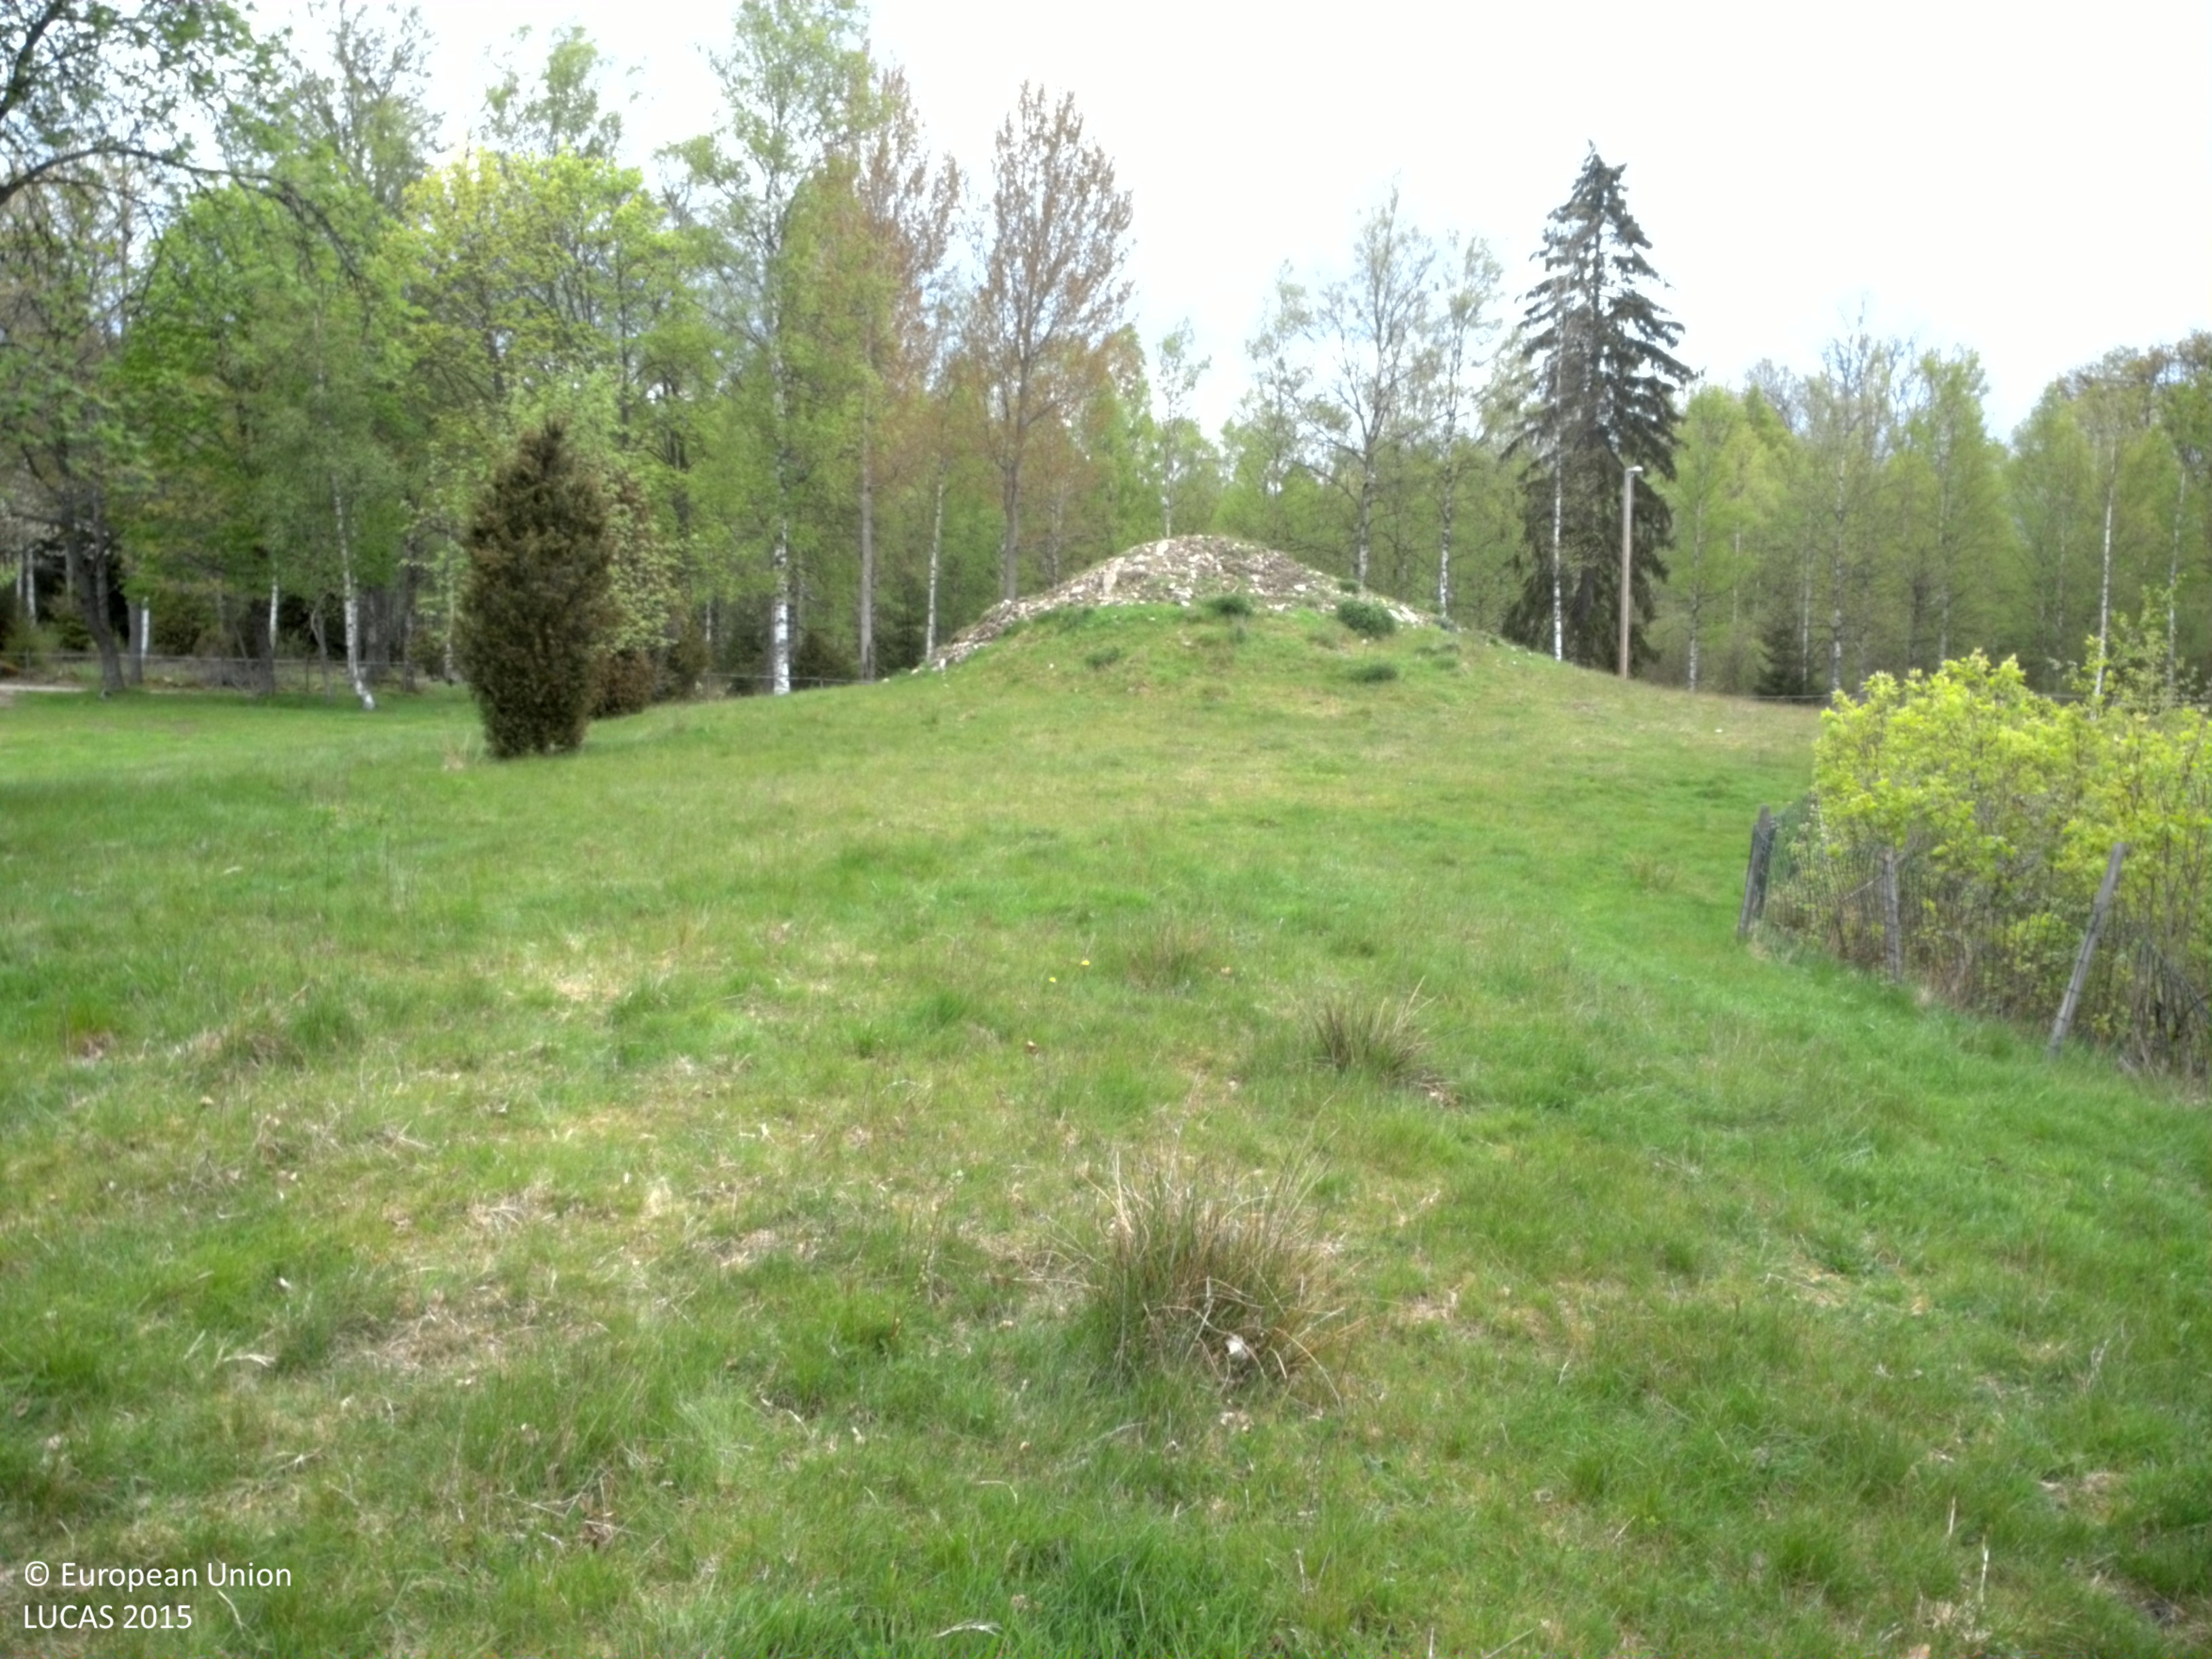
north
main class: Grassland
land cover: Grassland without tree/shrub cover
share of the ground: > 75 %
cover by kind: herbaceous plants 100 %
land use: Agriculture (excluding fallow land and kitchen gardens)
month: May
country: SE
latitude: 56.7984
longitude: 15.3197
